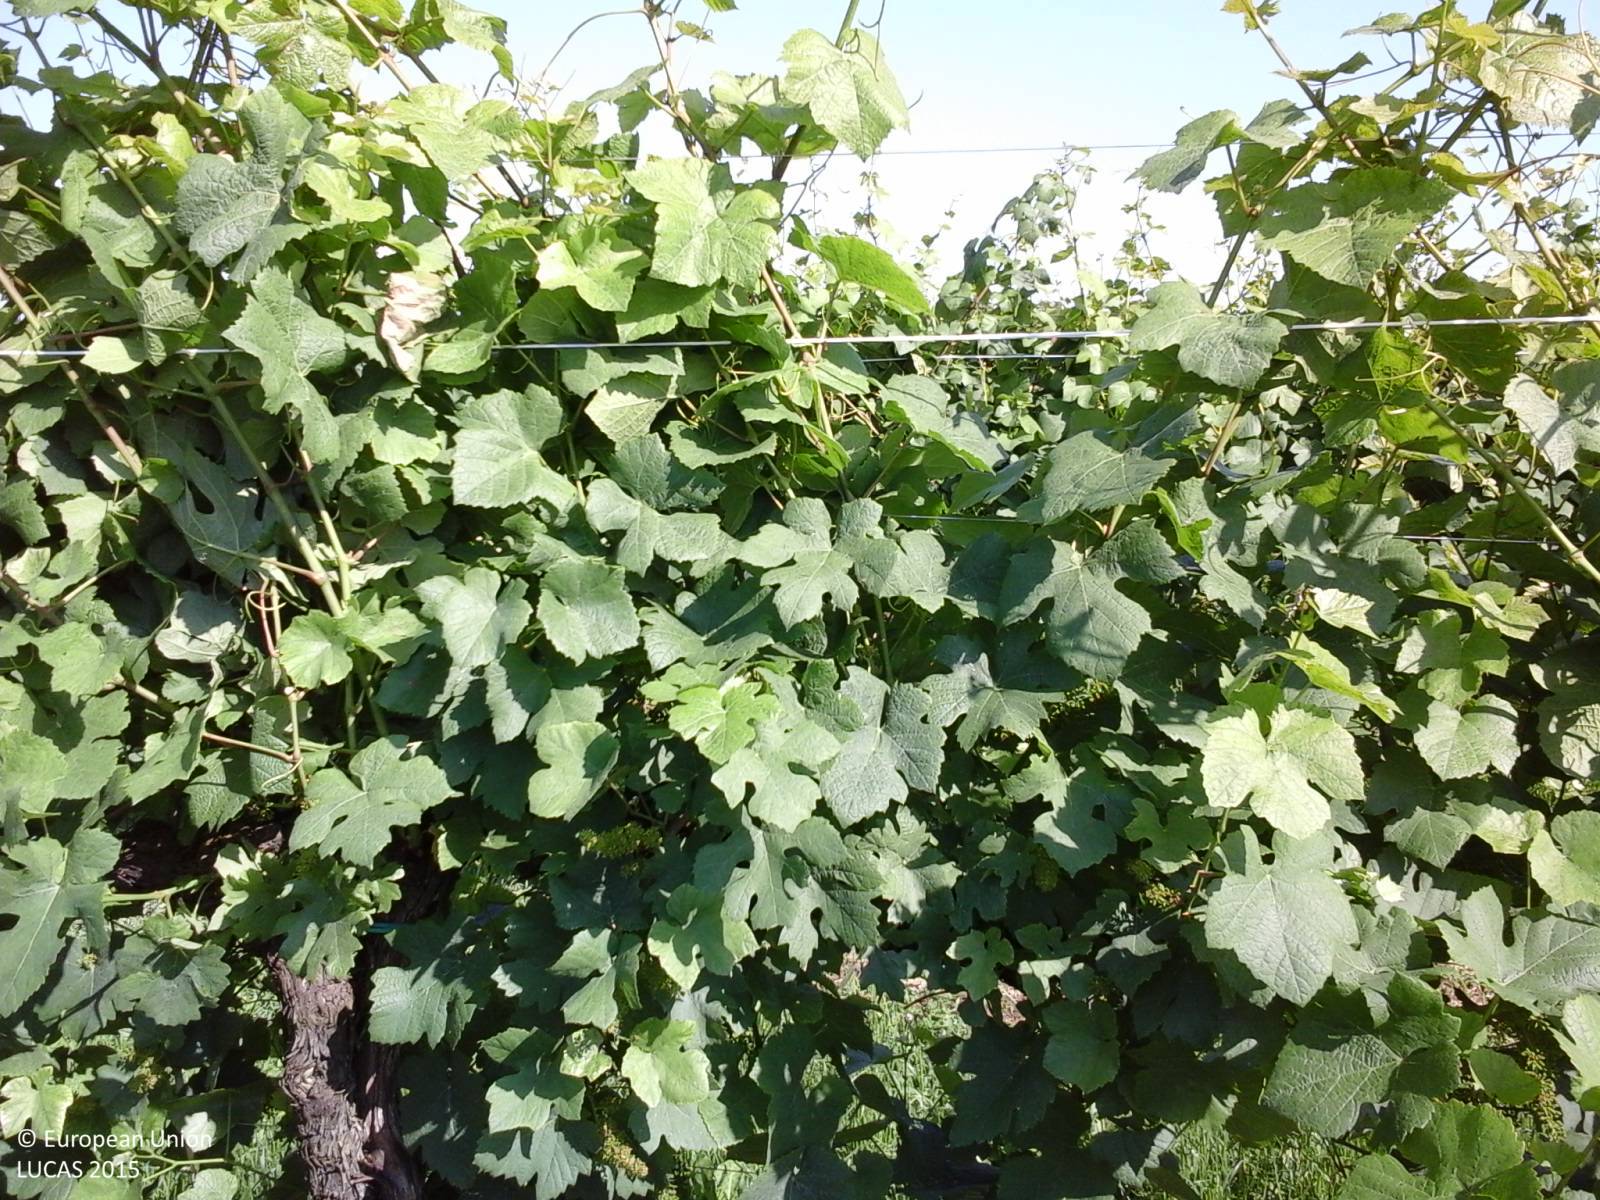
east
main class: Cropland
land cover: Vineyards
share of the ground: 50 - 75 %
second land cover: Grassland without tree/shrub cover
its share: 25 - 50 %
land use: Agriculture (excluding fallow land and kitchen gardens)
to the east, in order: Vineyards; Grassland without tree/shrub cover; Inland fresh running water; Tracks; Vineyards; Grass margins; Paved roads, cycling and walking lanes; Grass margins; Ditches and canals; Grass margins; Maize; Ditches and canals; Grass margins; Tracks; Grass margins; Vineyards
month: June
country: IT
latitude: 45.8122
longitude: 12.7118
